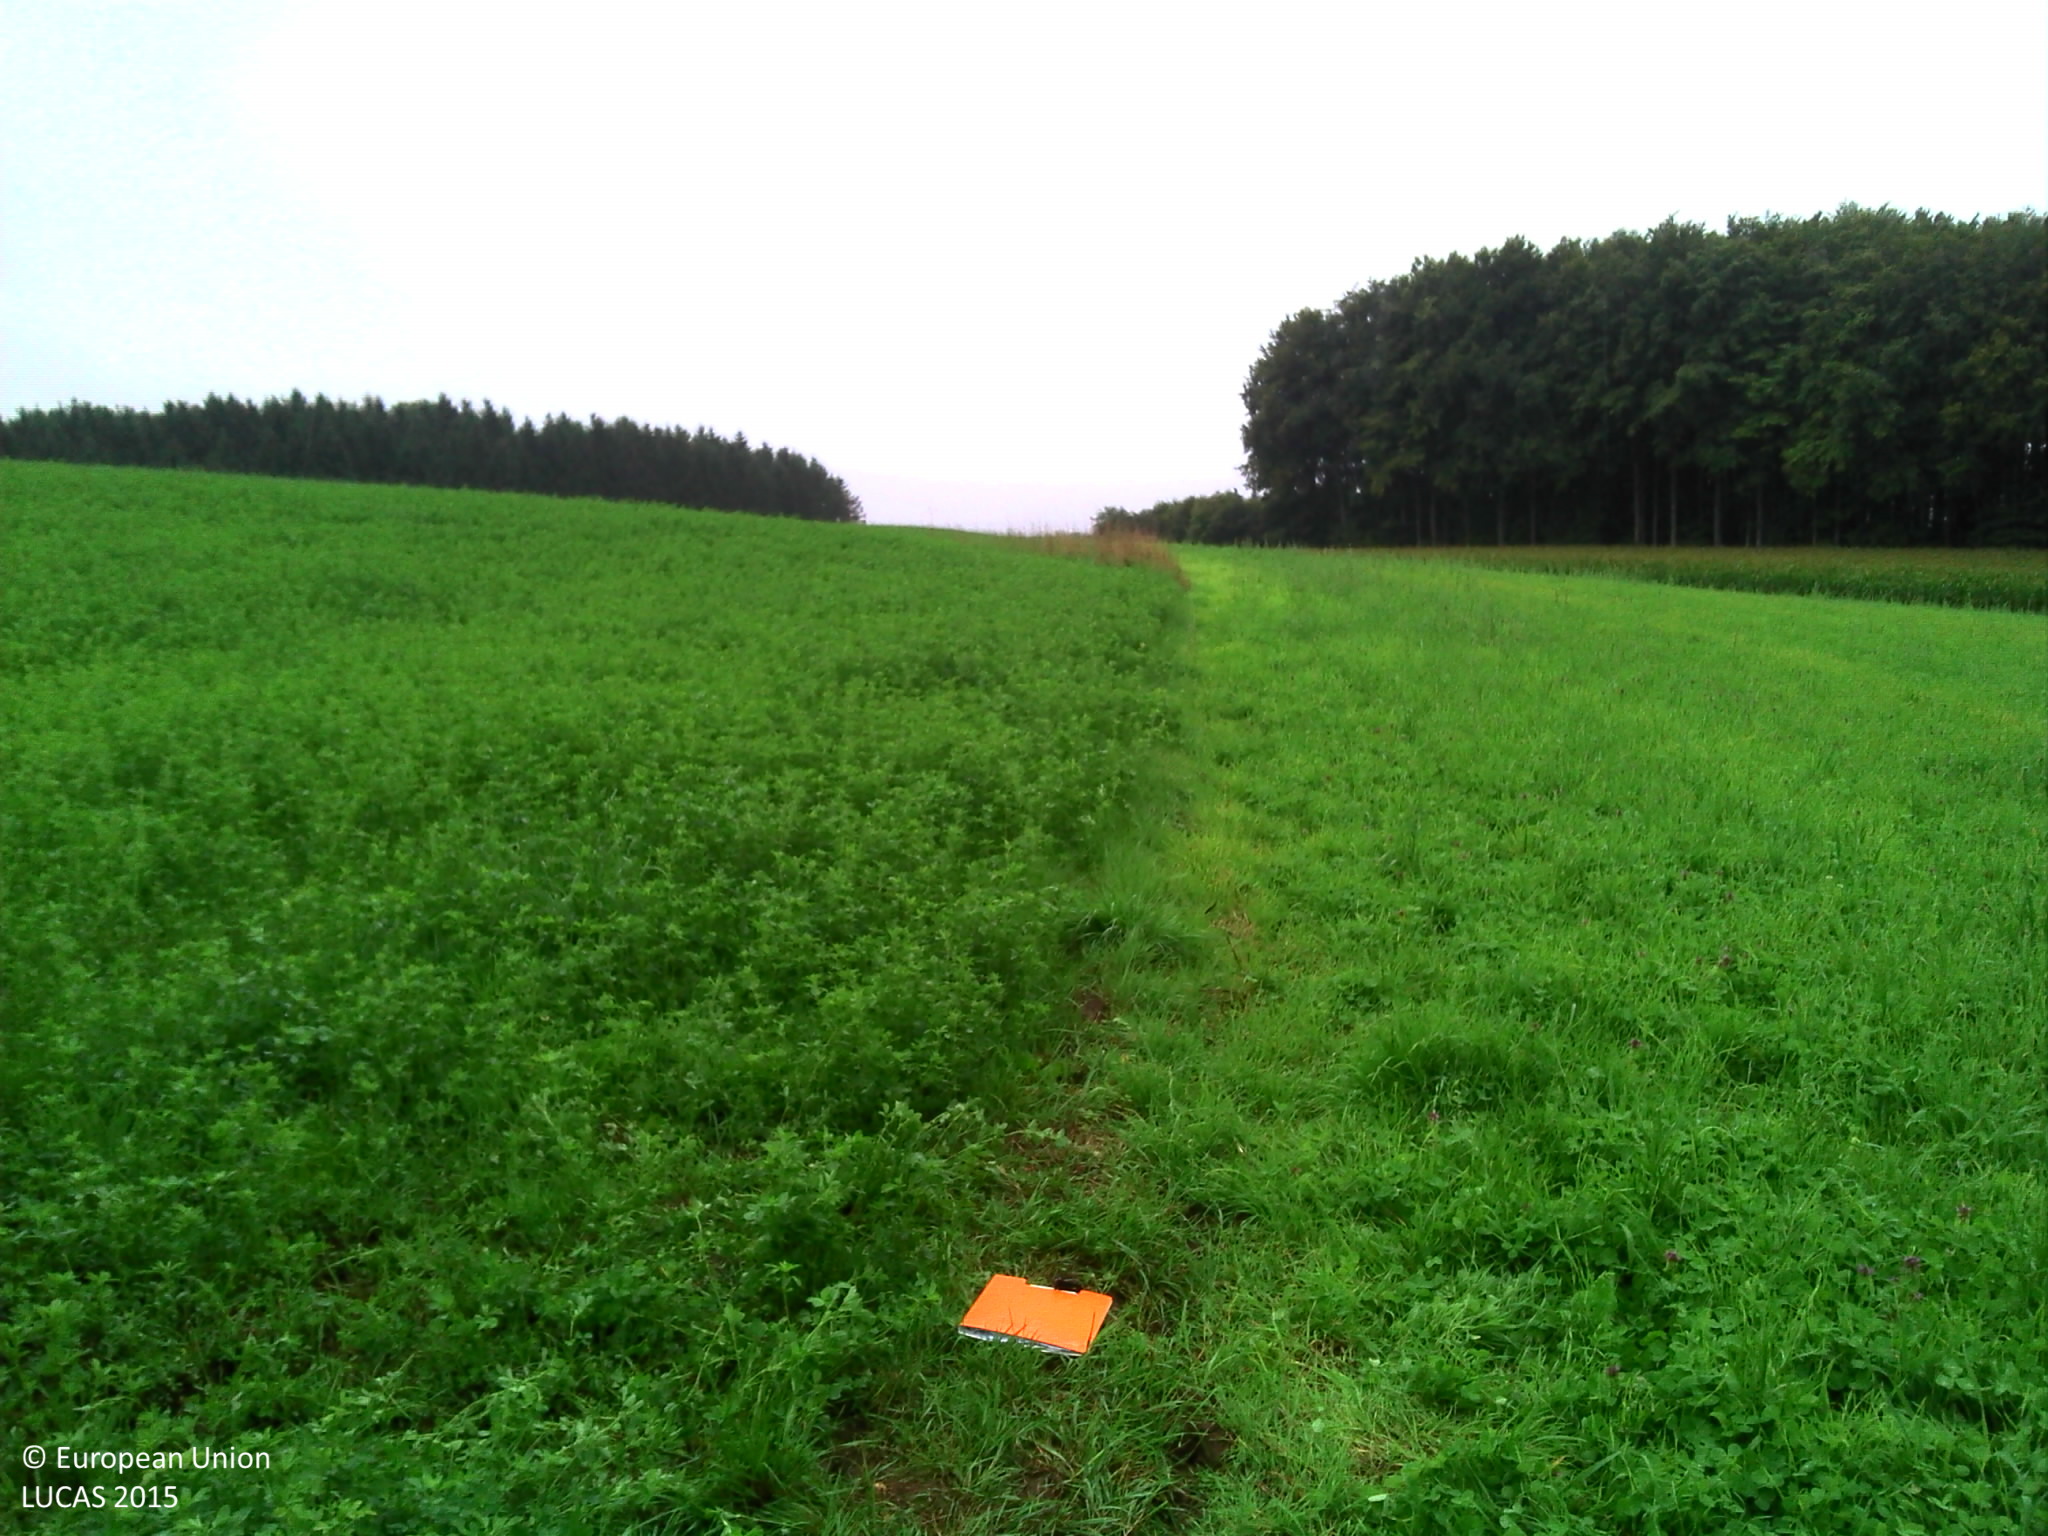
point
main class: Cropland
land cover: Lucerne
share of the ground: > 75 %
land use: Agriculture (excluding fallow land and kitchen gardens)
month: September
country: LU
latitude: 49.7855
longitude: 5.8739
